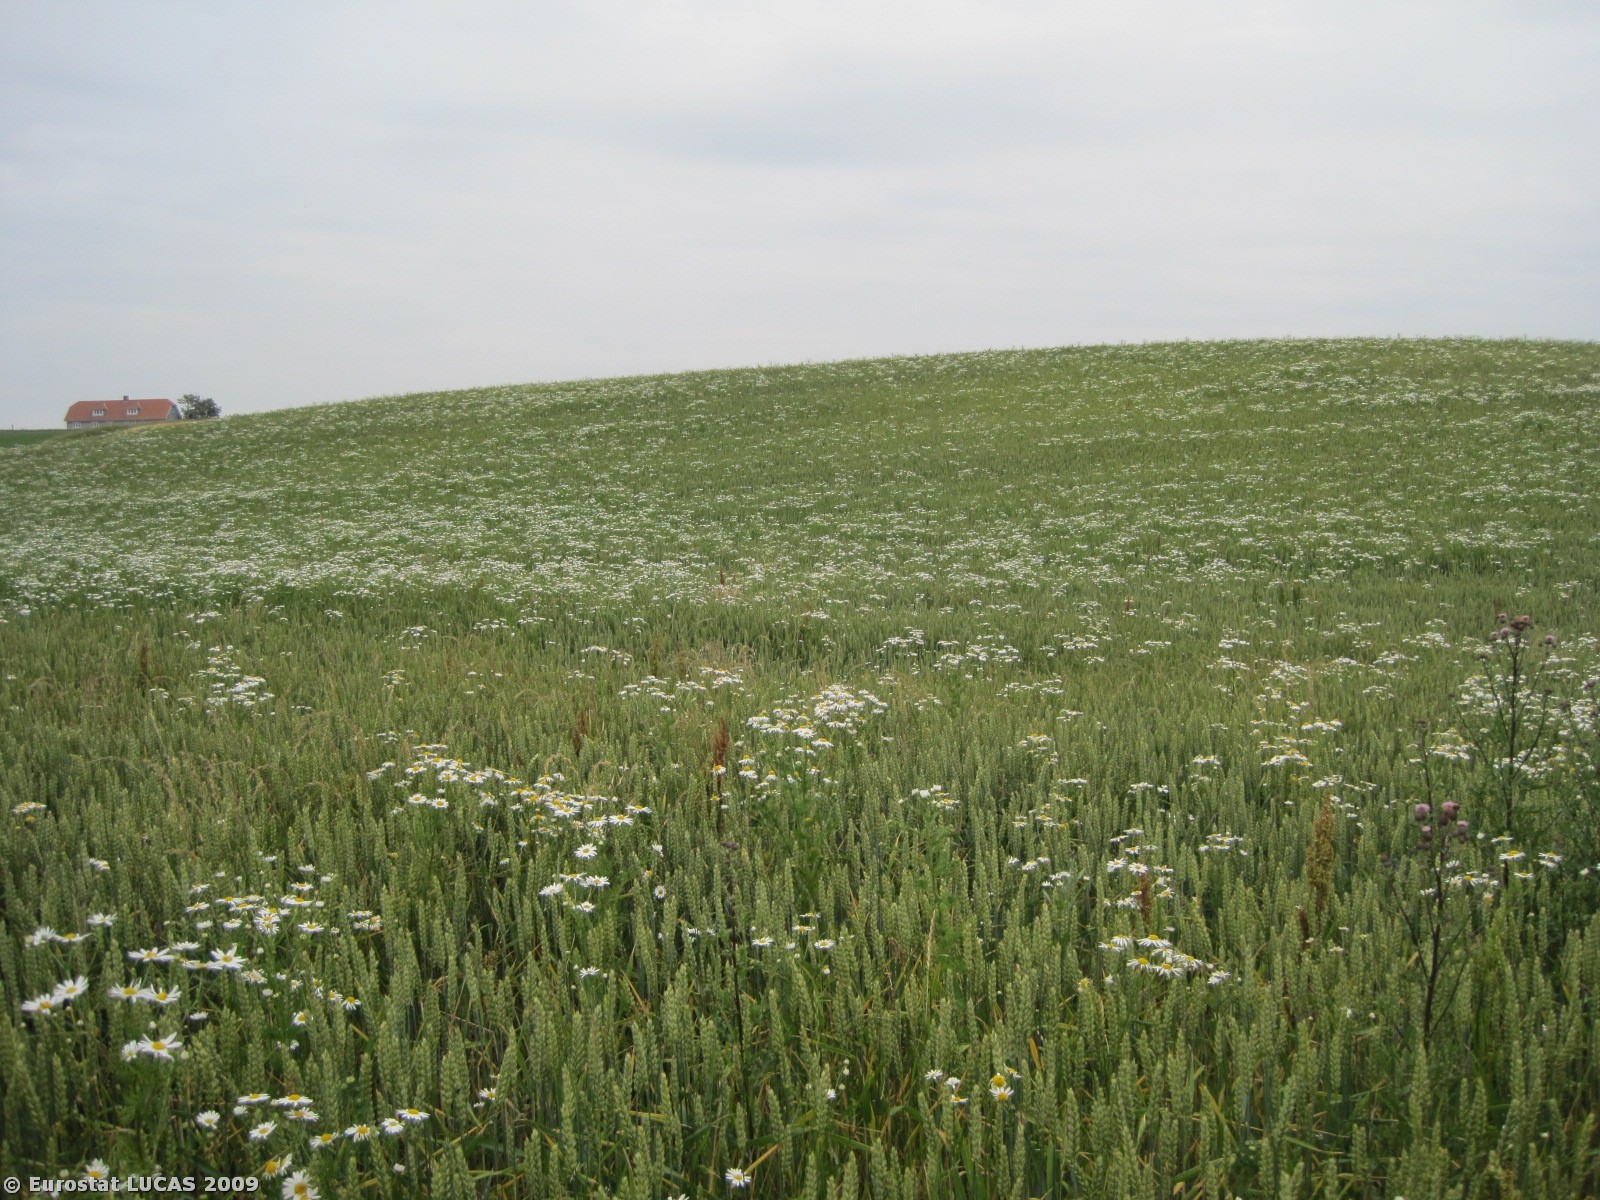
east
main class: Grassland
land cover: Grassland with sparse tree/shrub cover
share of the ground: > 75 %
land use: Agriculture (excluding fallow land and kitchen gardens)
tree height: < 5 m
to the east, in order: Grassland with sparse tree/shrub cover; Fences; Grass margins; Common wheat; Grass margins; Tracks; Grass margins; Fences; Grassland without tree/shrub cover; Fences; Grass margins; Barley; Grass margins; Fences; Grassland without tree/shrub cover; Fences; Grass margins; Barley
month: June
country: DK
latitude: 56.5365
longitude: 8.3272
